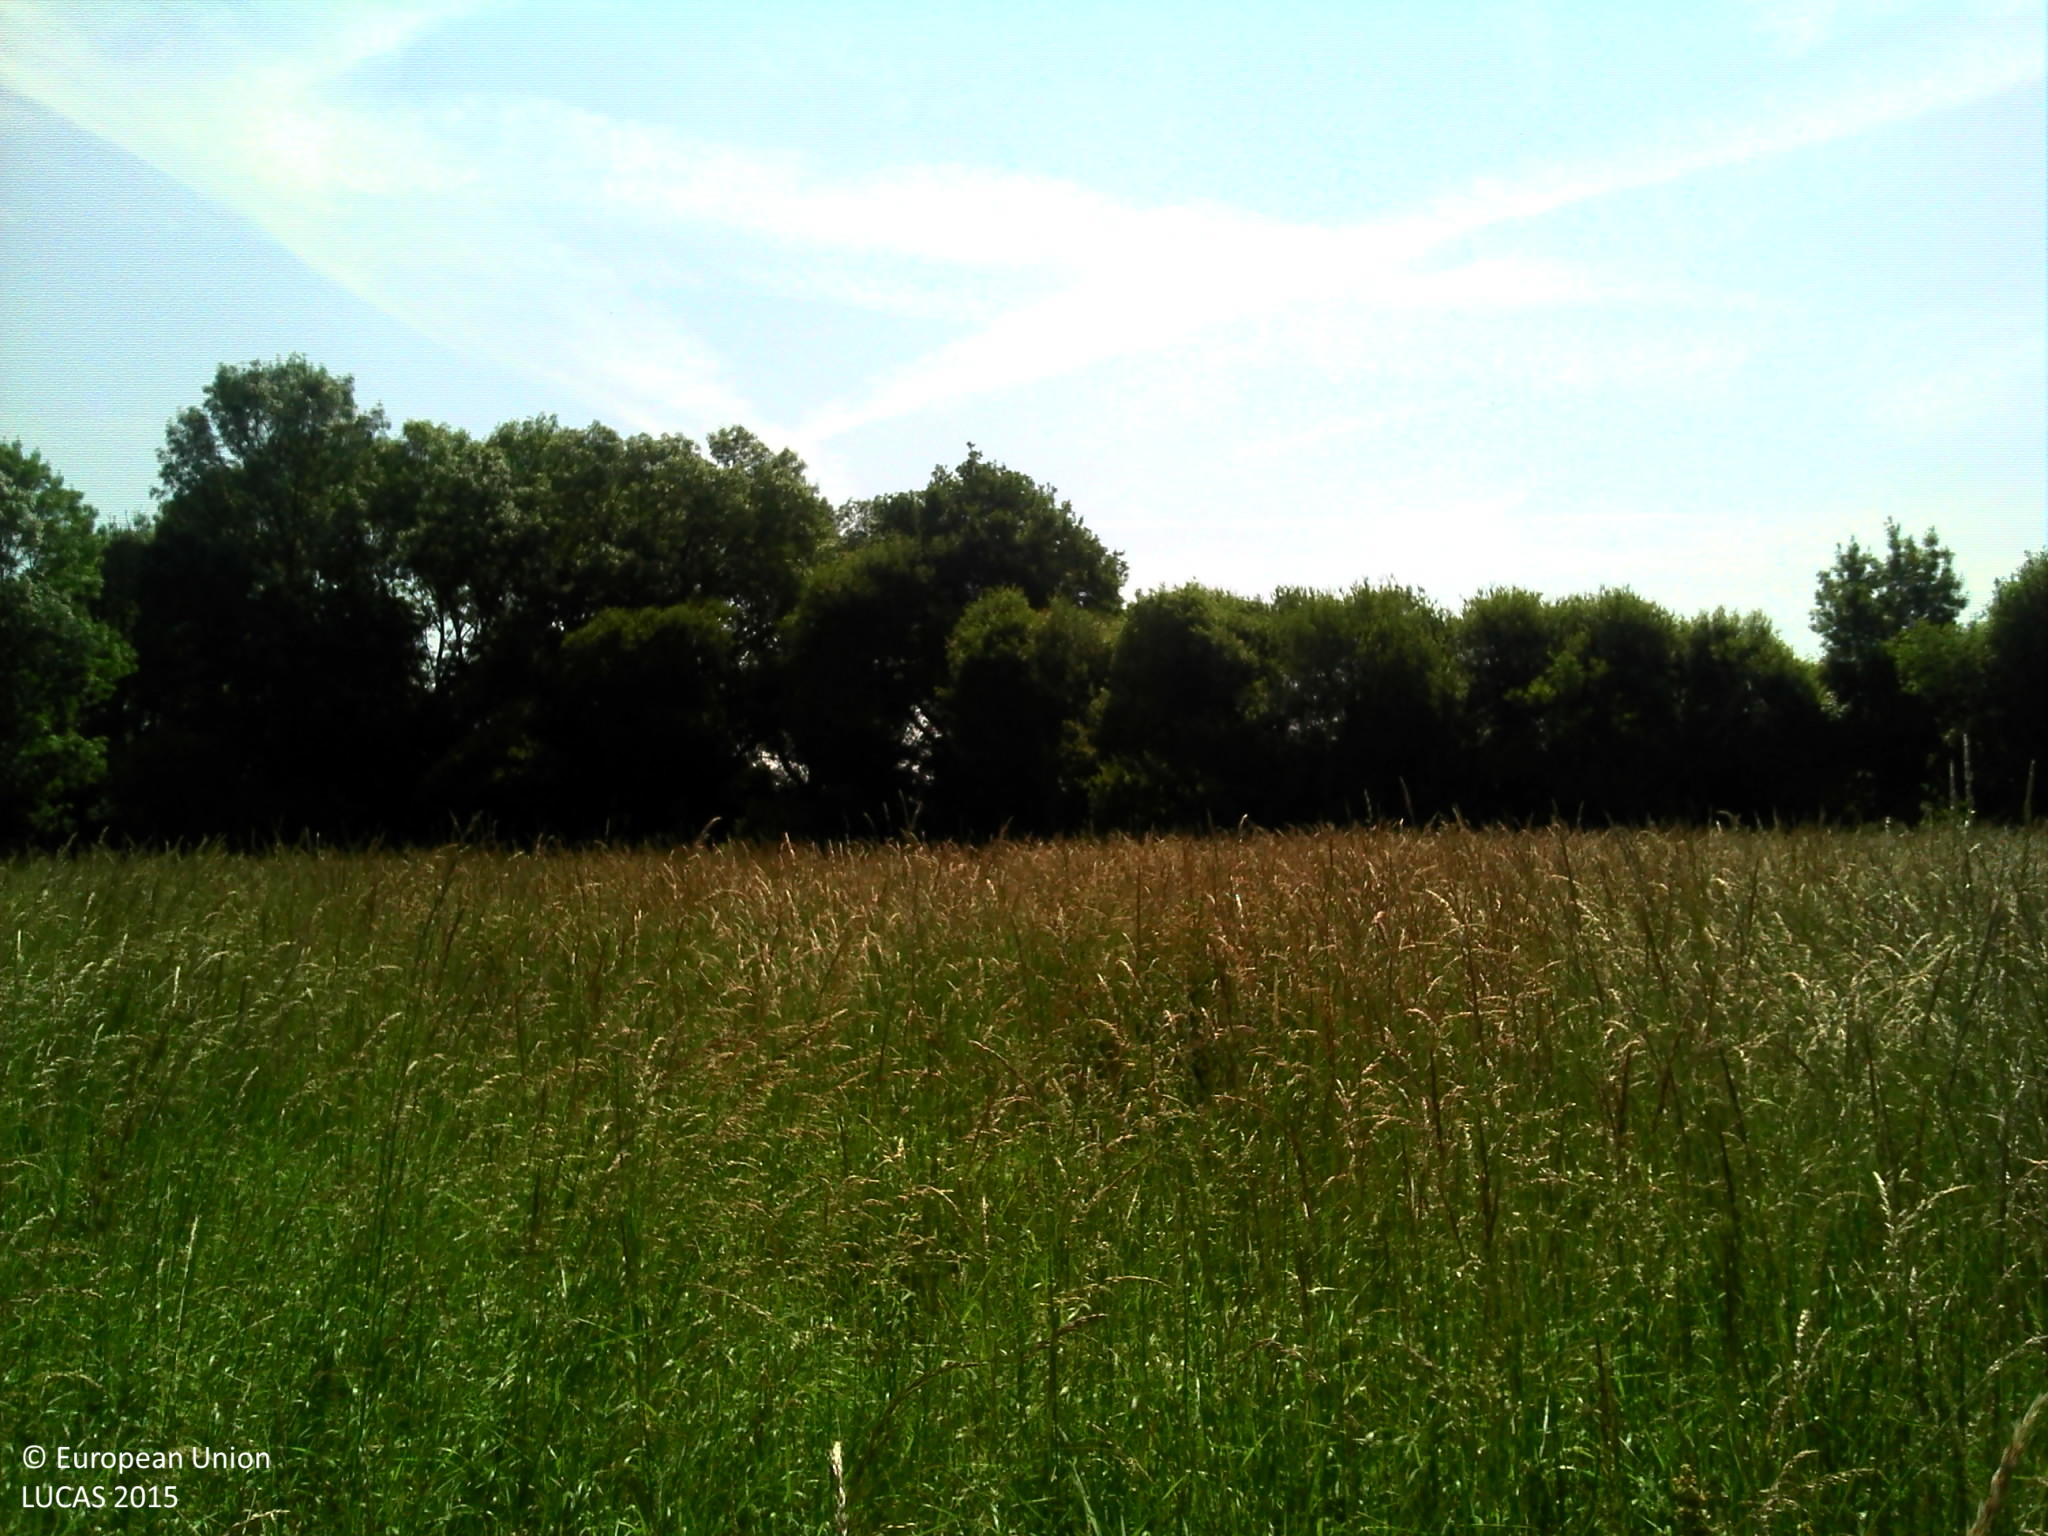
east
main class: Grassland
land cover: Grassland without tree/shrub cover
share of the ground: > 75 %
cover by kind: herbaceous plants 100 %
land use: Agriculture (excluding fallow land and kitchen gardens)
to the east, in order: Grassland without tree/shrub cover; Grass margins; Rivers and streams; Broadleaved woodland; Grass margins; Tracks; Ditches and canals; Grass margins; Broadleaved woodland; Fences; Grassland without tree/shrub cover; Fences; Abandoned hedges; Fences; Grassland without tree/shrub cover
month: June
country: FR
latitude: 47.6994
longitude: 0.0461
